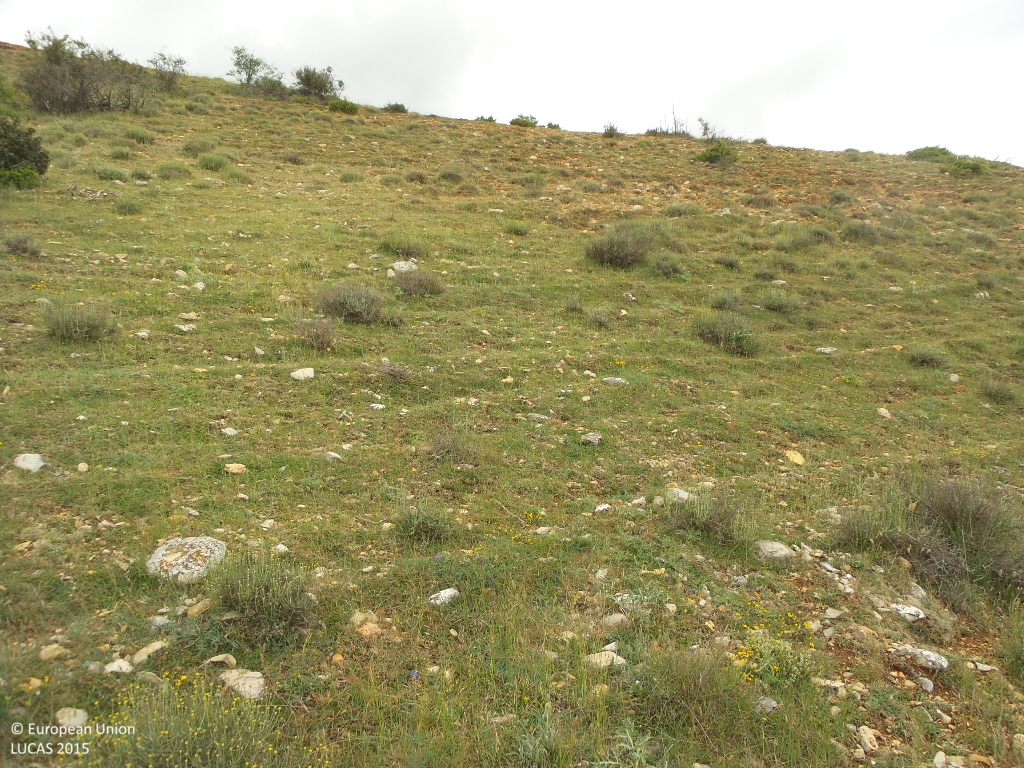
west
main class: Shrubland
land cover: Shrubland without tree cover
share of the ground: 10 - 25 %
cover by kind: herbaceous plants 85 %, shrubs 10 %, unconsolidated bare surface 5 %
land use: Agriculture (excluding fallow land and kitchen gardens)
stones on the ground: < 10 %
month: June
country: ES
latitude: 41.2969
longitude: -3.1658
